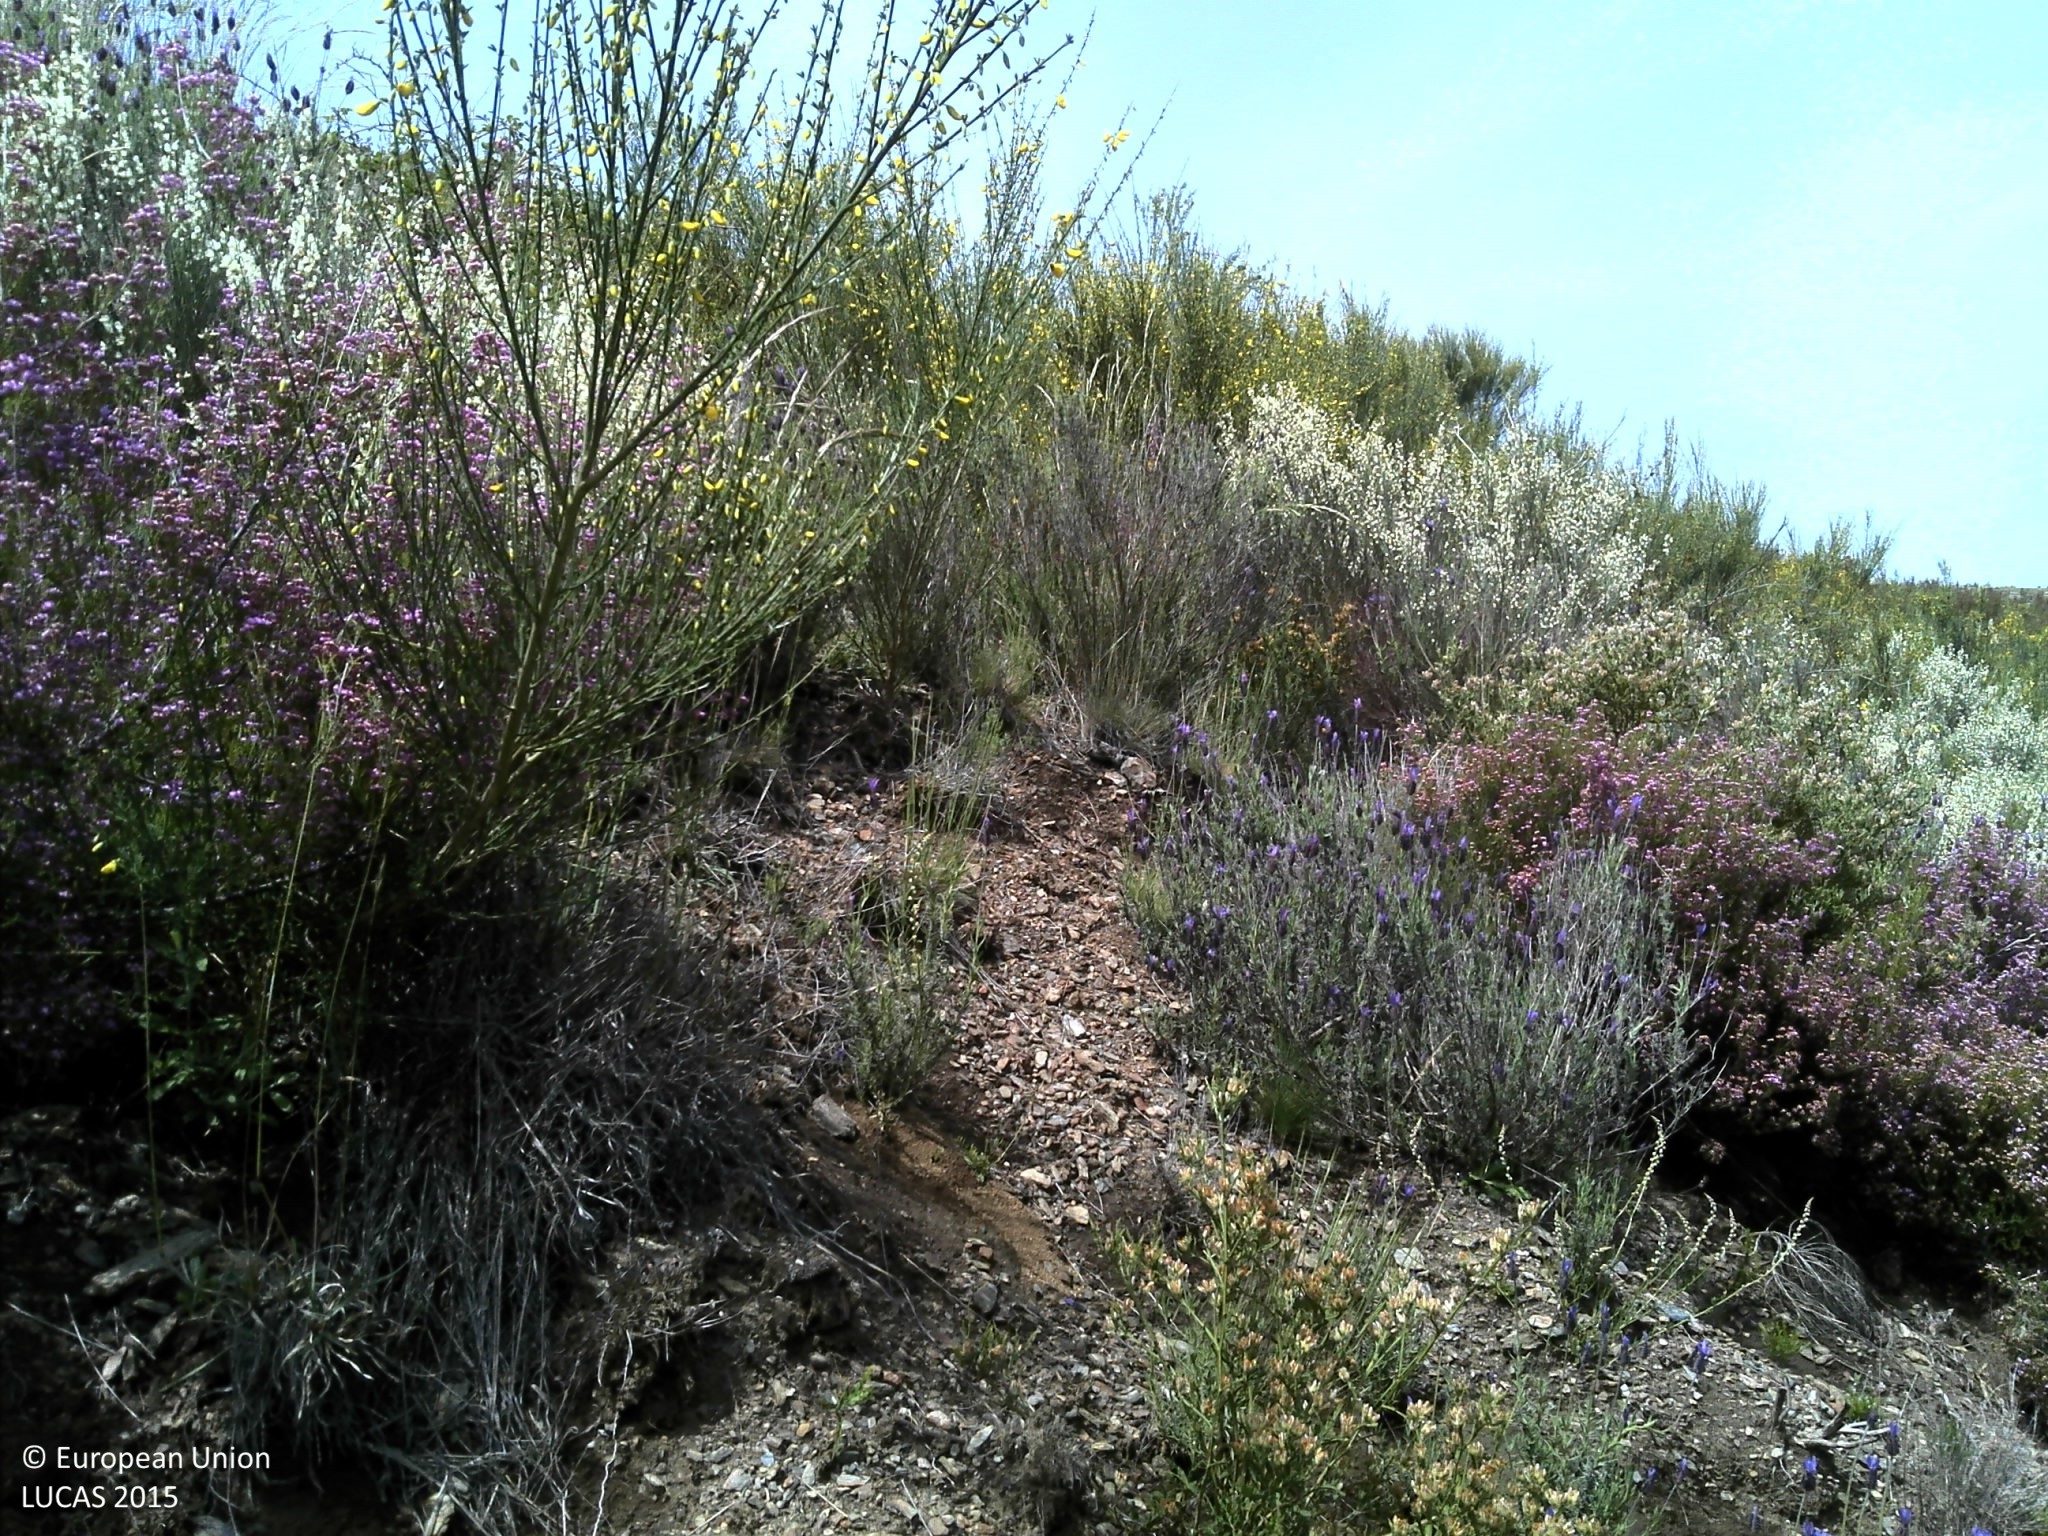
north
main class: Shrubland
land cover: Shrubland without tree cover
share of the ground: 25 - 50 %
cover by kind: shrubs 50 %, unconsolidated bare surface 40 %, herbaceous plants 10 %
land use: Semi-natural and natural areas not in use
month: May
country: PT
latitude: 41.9257
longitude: -7.0898
